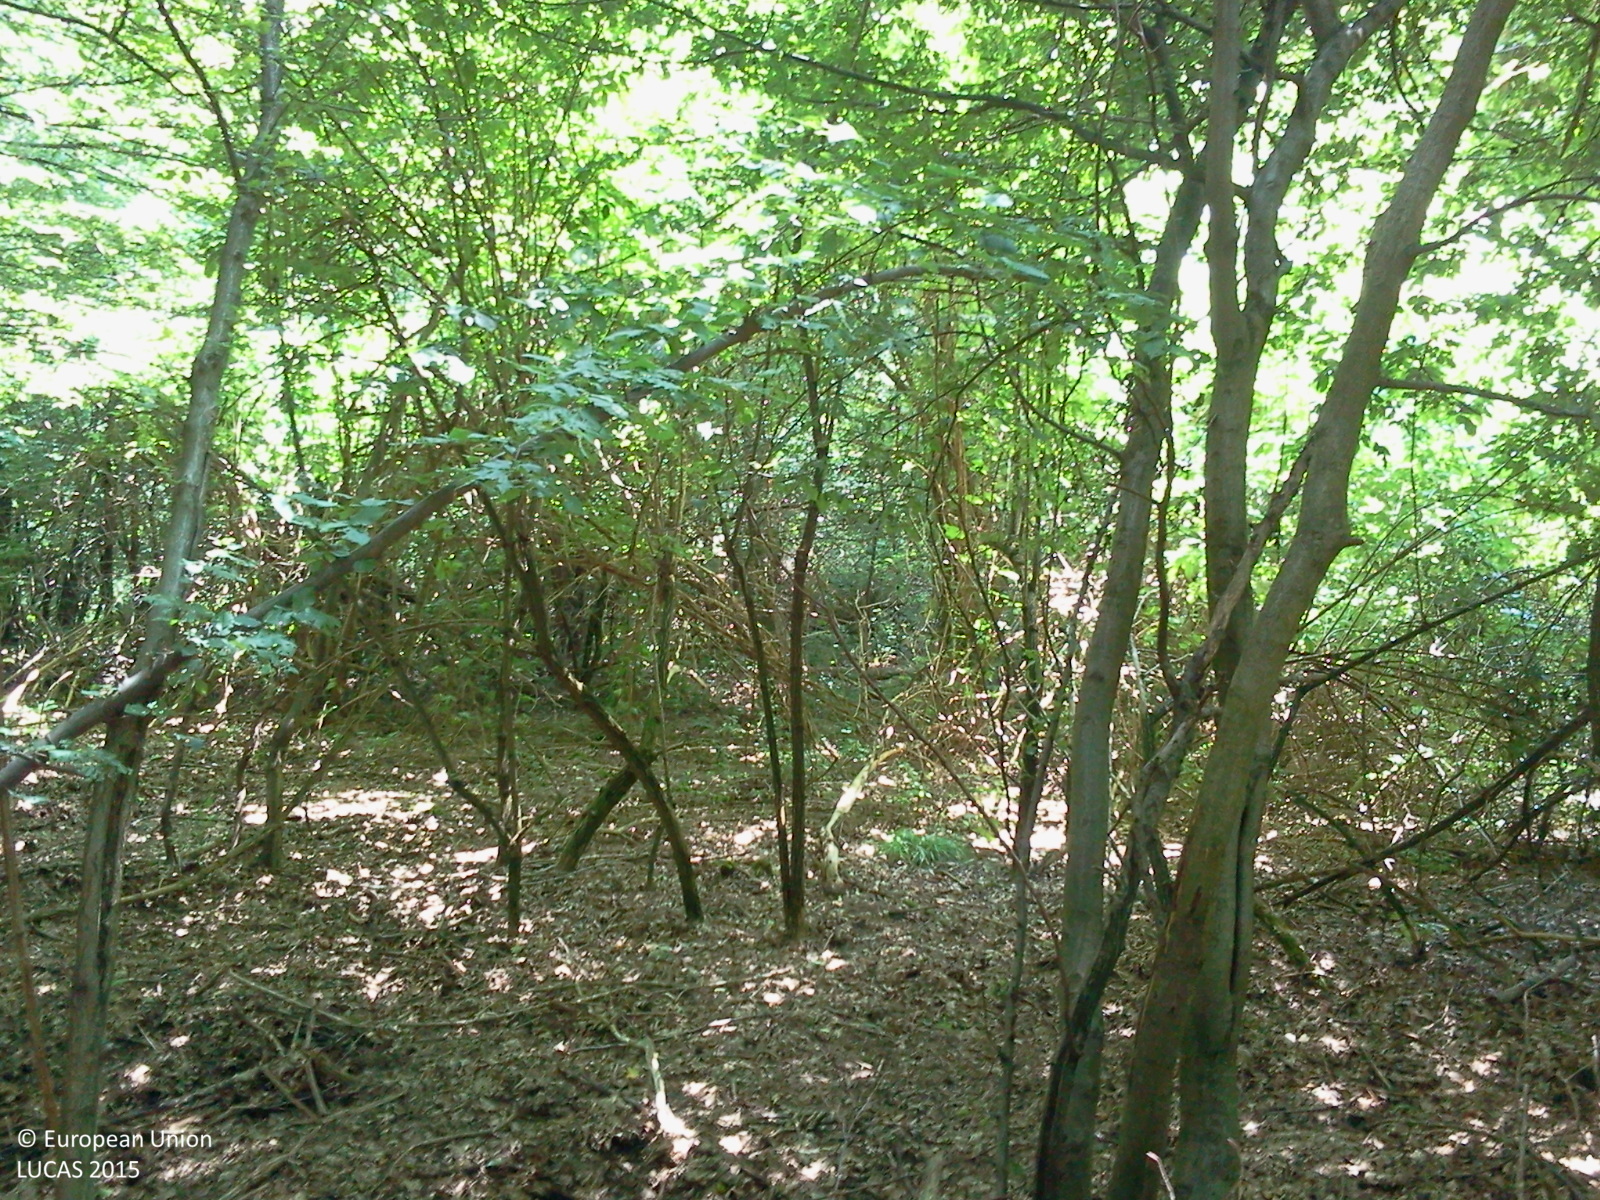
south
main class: Woodland
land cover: Broadleaved woodland
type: thermophilous deciduous forest
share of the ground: > 75 %
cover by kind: broadleaved forest trees 95 %, unconsolidated bare surface 5 %
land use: Forestry
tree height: > 5 m
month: June
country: HU
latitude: 46.8434
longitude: 17.0194
